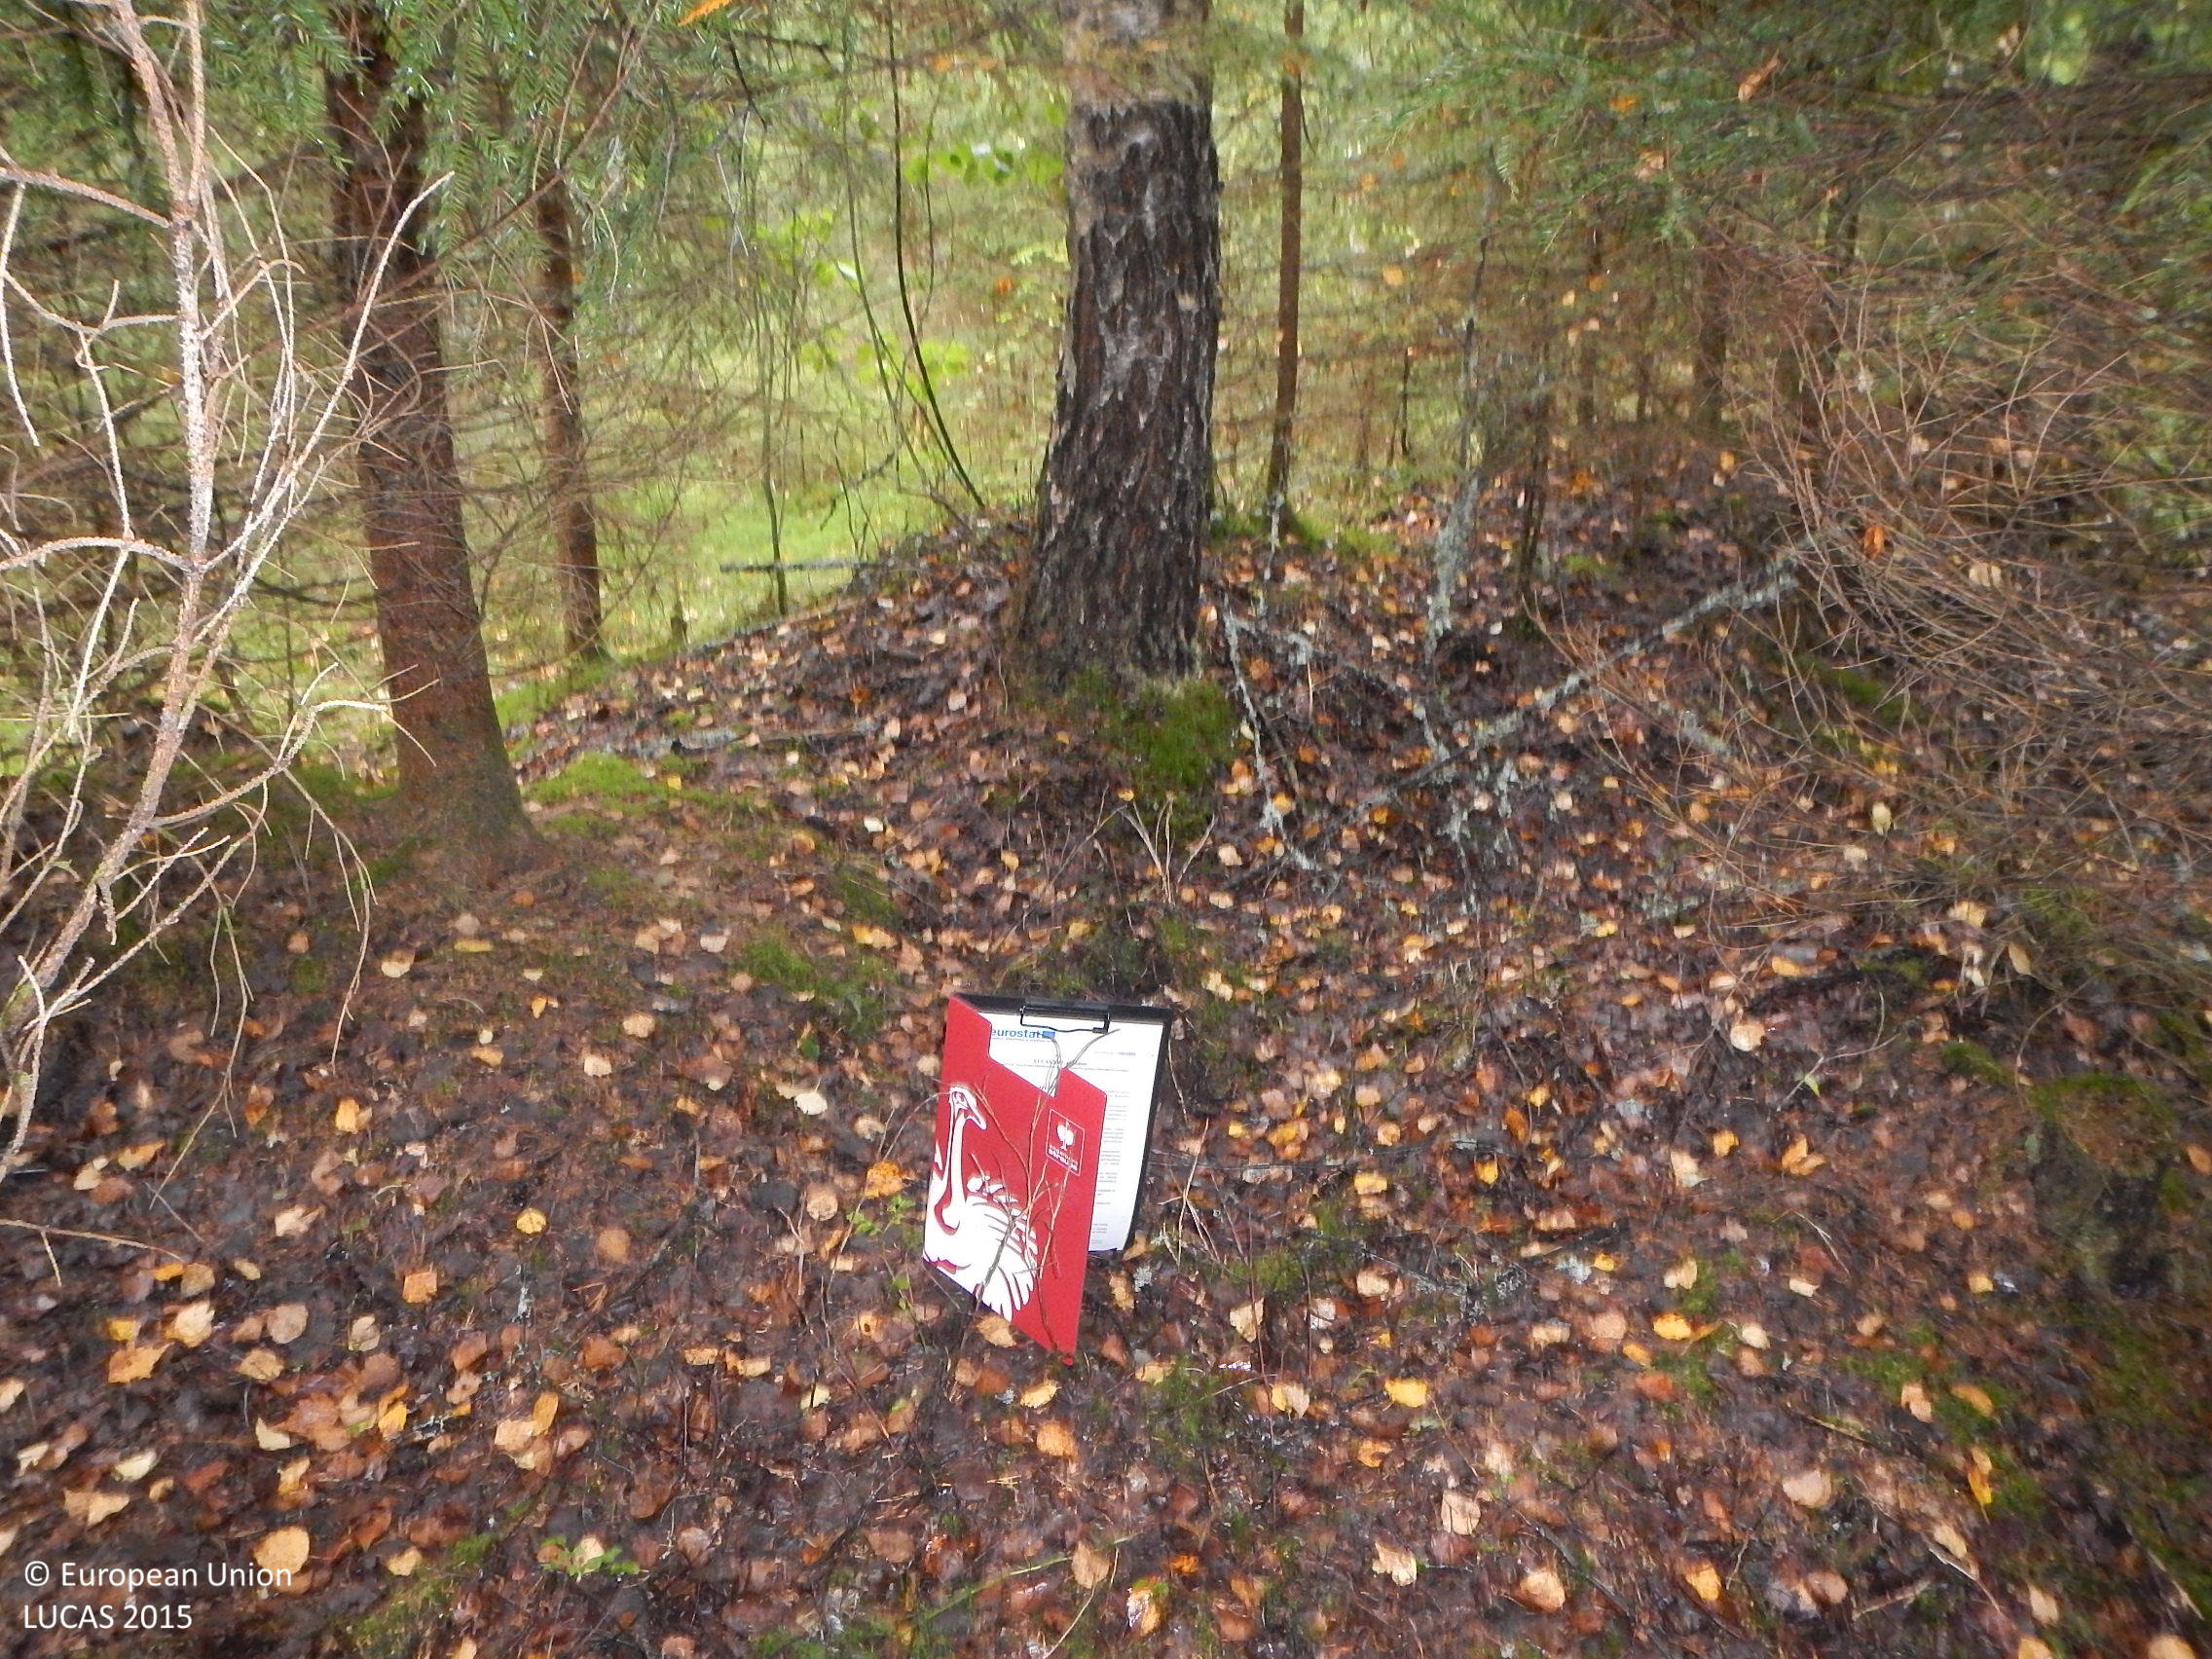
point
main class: Woodland
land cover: Other mixed woodland
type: boreal forest
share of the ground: > 75 %
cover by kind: coniferous forest trees 65 %, broadleaved forest trees 30 %, lichens and mosses 5 %
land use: Forestry
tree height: > 5 m
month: September
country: FI
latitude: 61.4566
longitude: 23.0355
